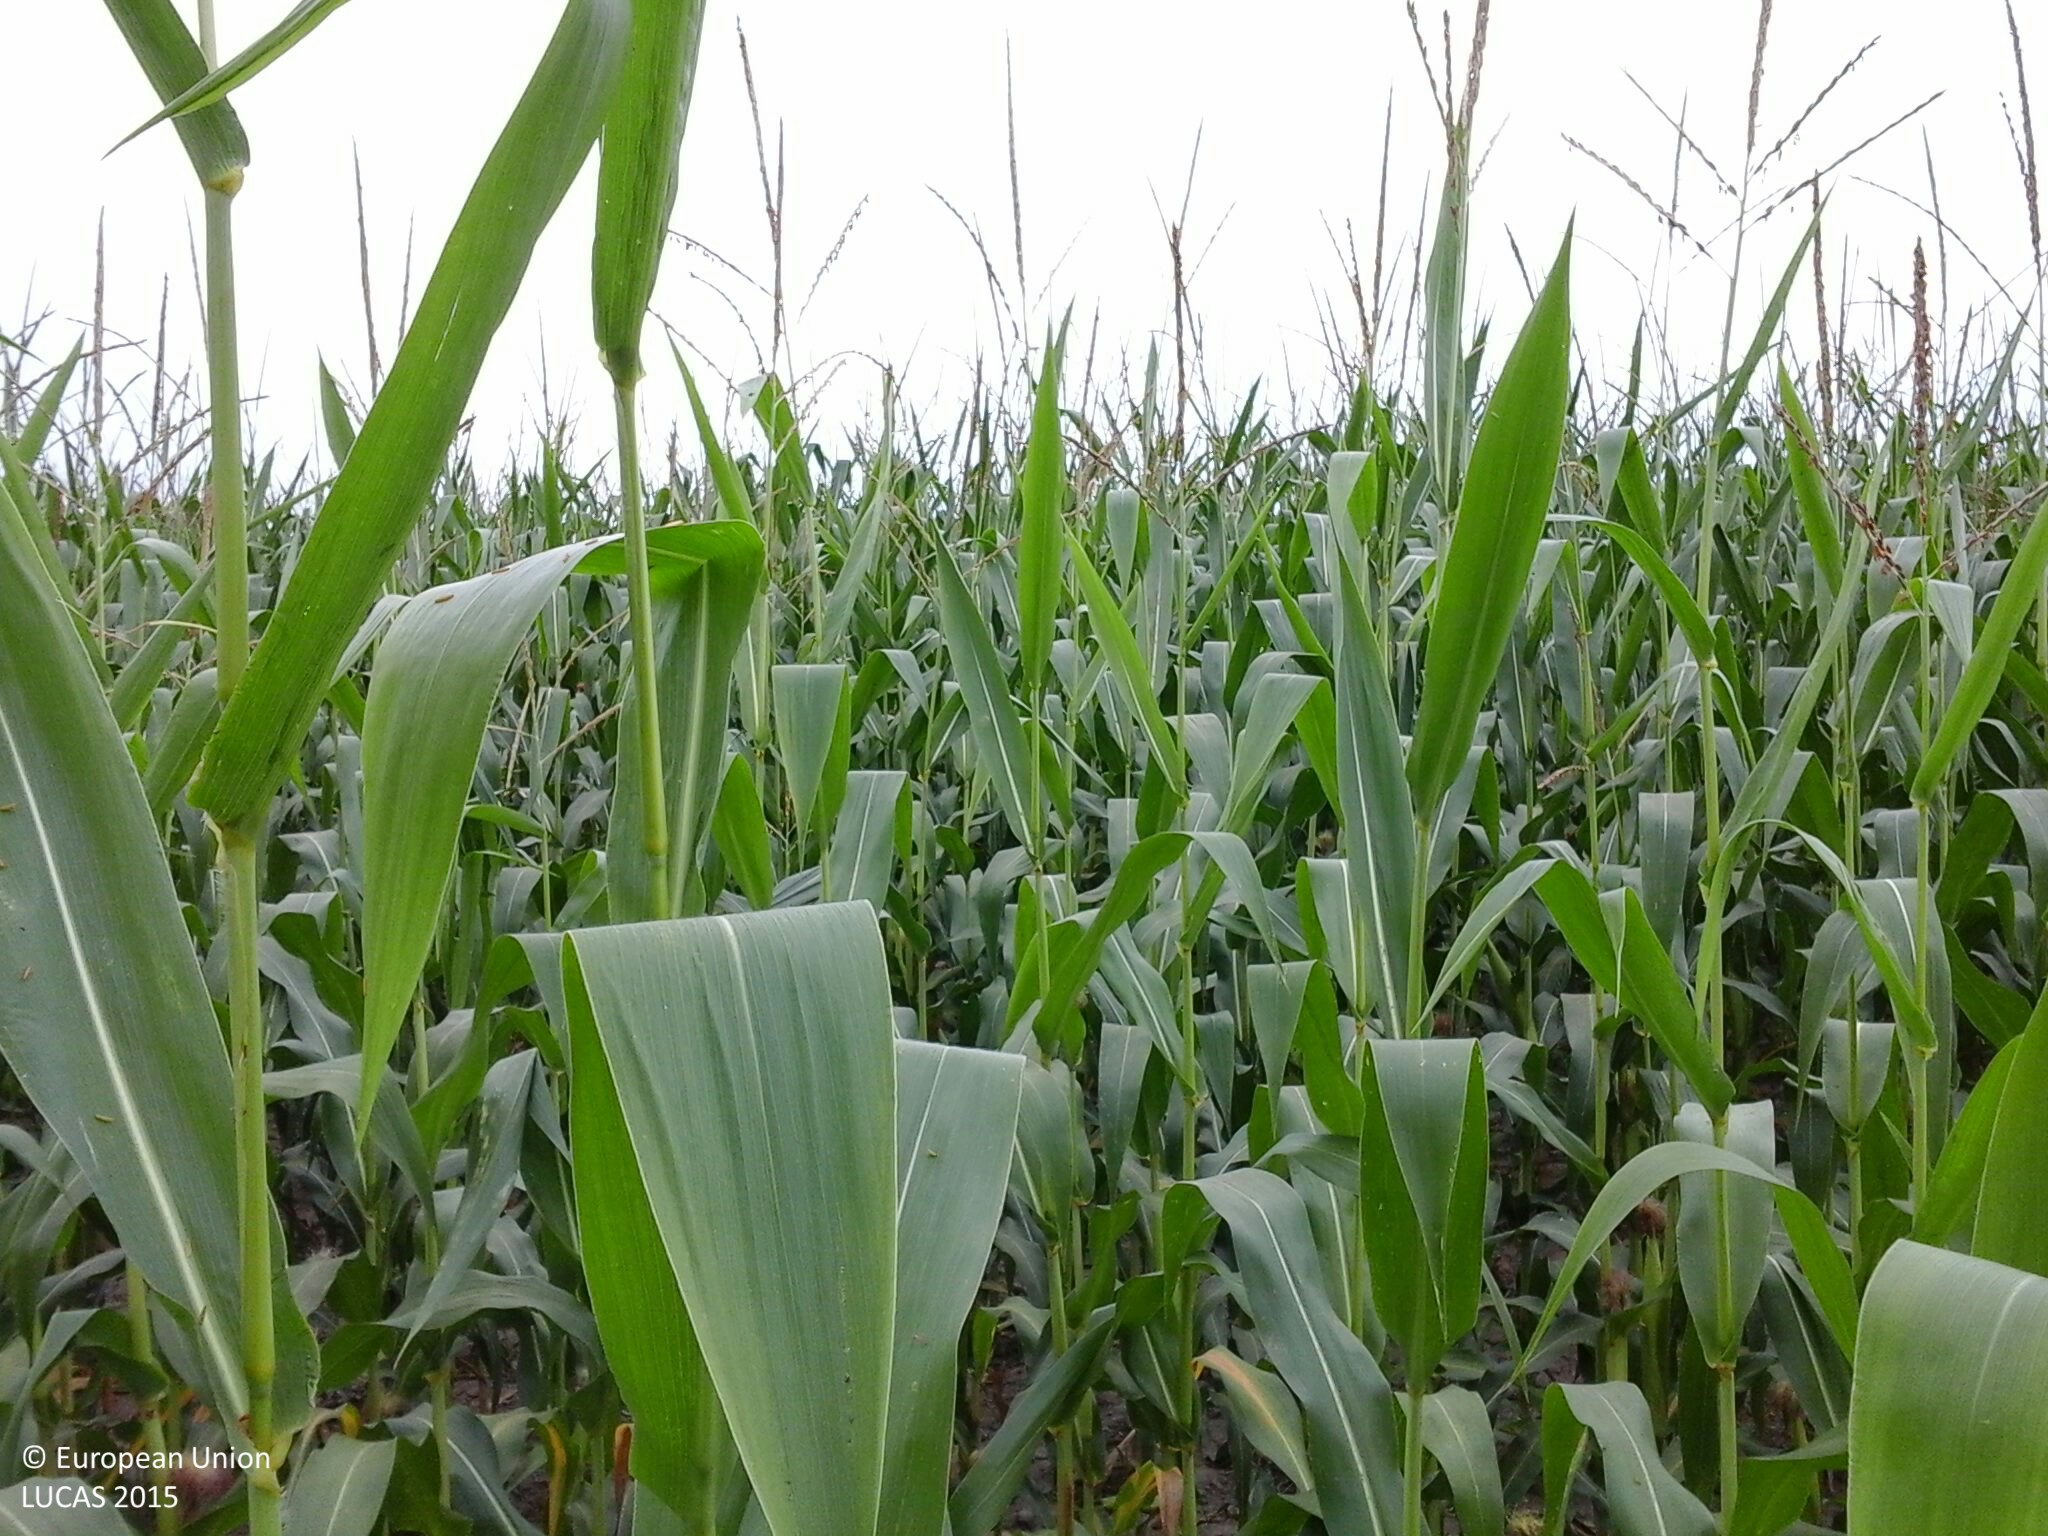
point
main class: Cropland
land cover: Maize
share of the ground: > 75 %
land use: Agriculture (excluding fallow land and kitchen gardens)
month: July
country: HU
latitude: 46.6463
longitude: 16.4164
